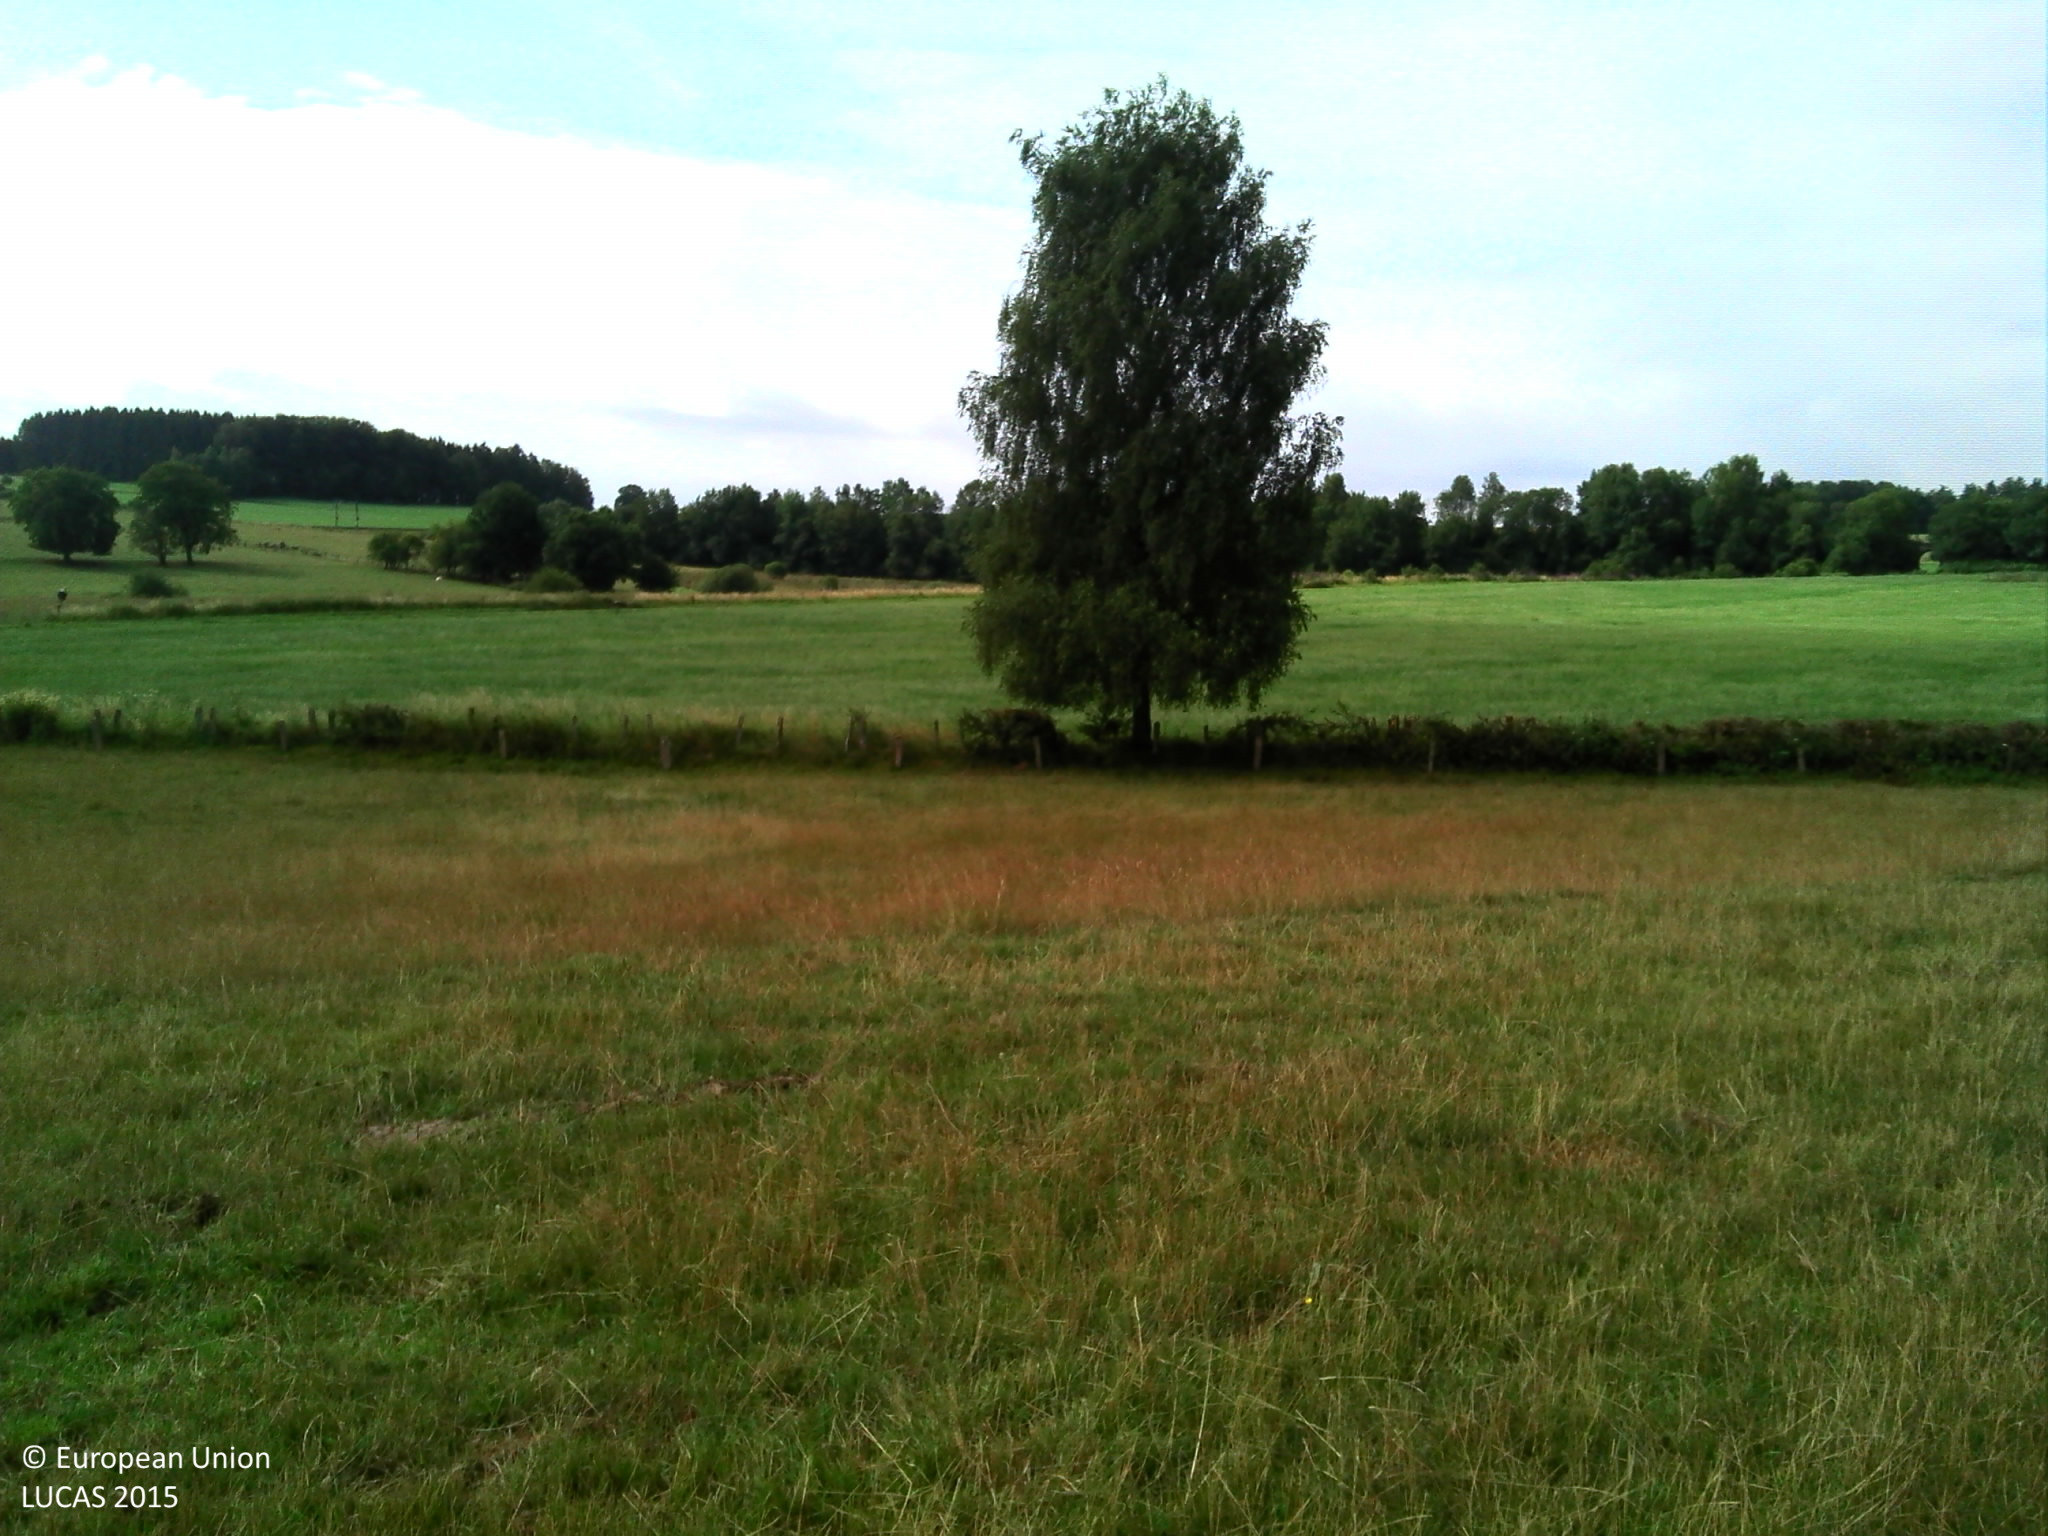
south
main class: Grassland
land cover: Grassland without tree/shrub cover
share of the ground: > 75 %
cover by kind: herbaceous plants 100 %
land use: Agriculture (excluding fallow land and kitchen gardens)
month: July
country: BE
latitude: 49.8346
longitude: 5.2848
